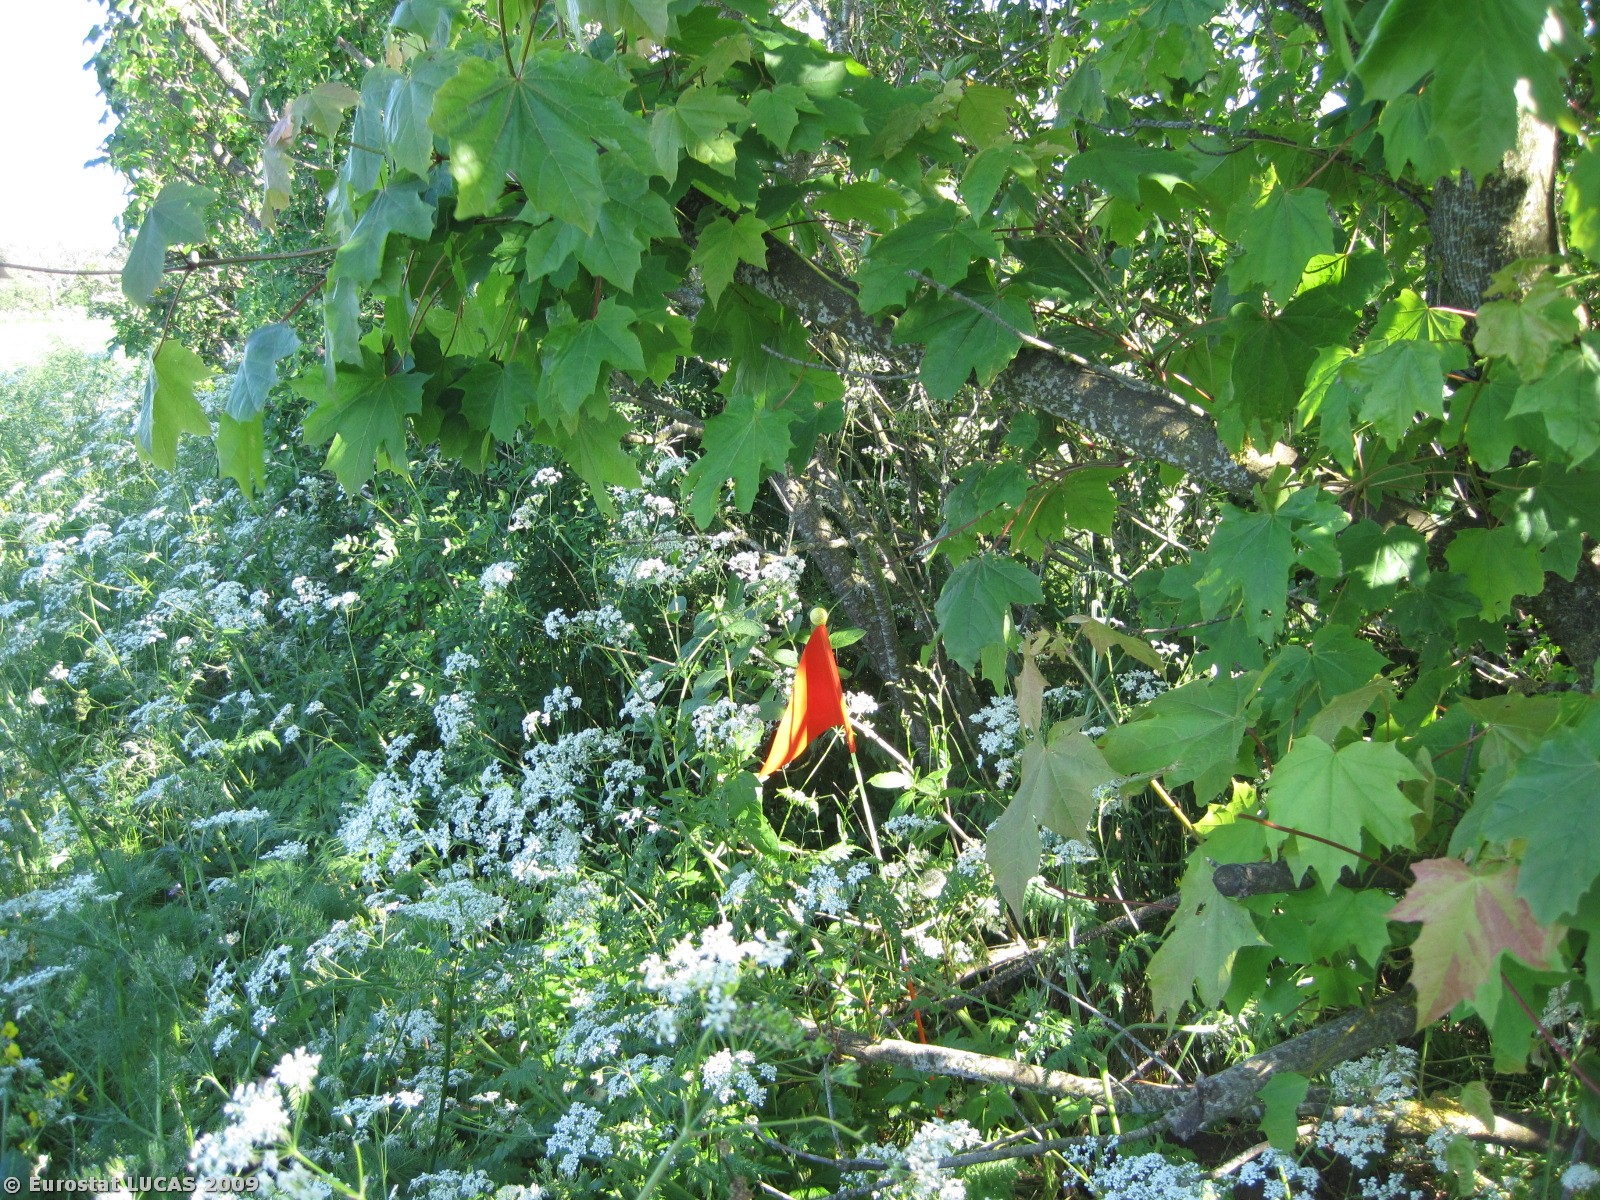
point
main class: Woodland
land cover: Broadleaved woodland
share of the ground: > 75 %
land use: Agriculture (excluding fallow land and kitchen gardens)
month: June
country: DK
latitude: 57.4821
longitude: 10.0500
